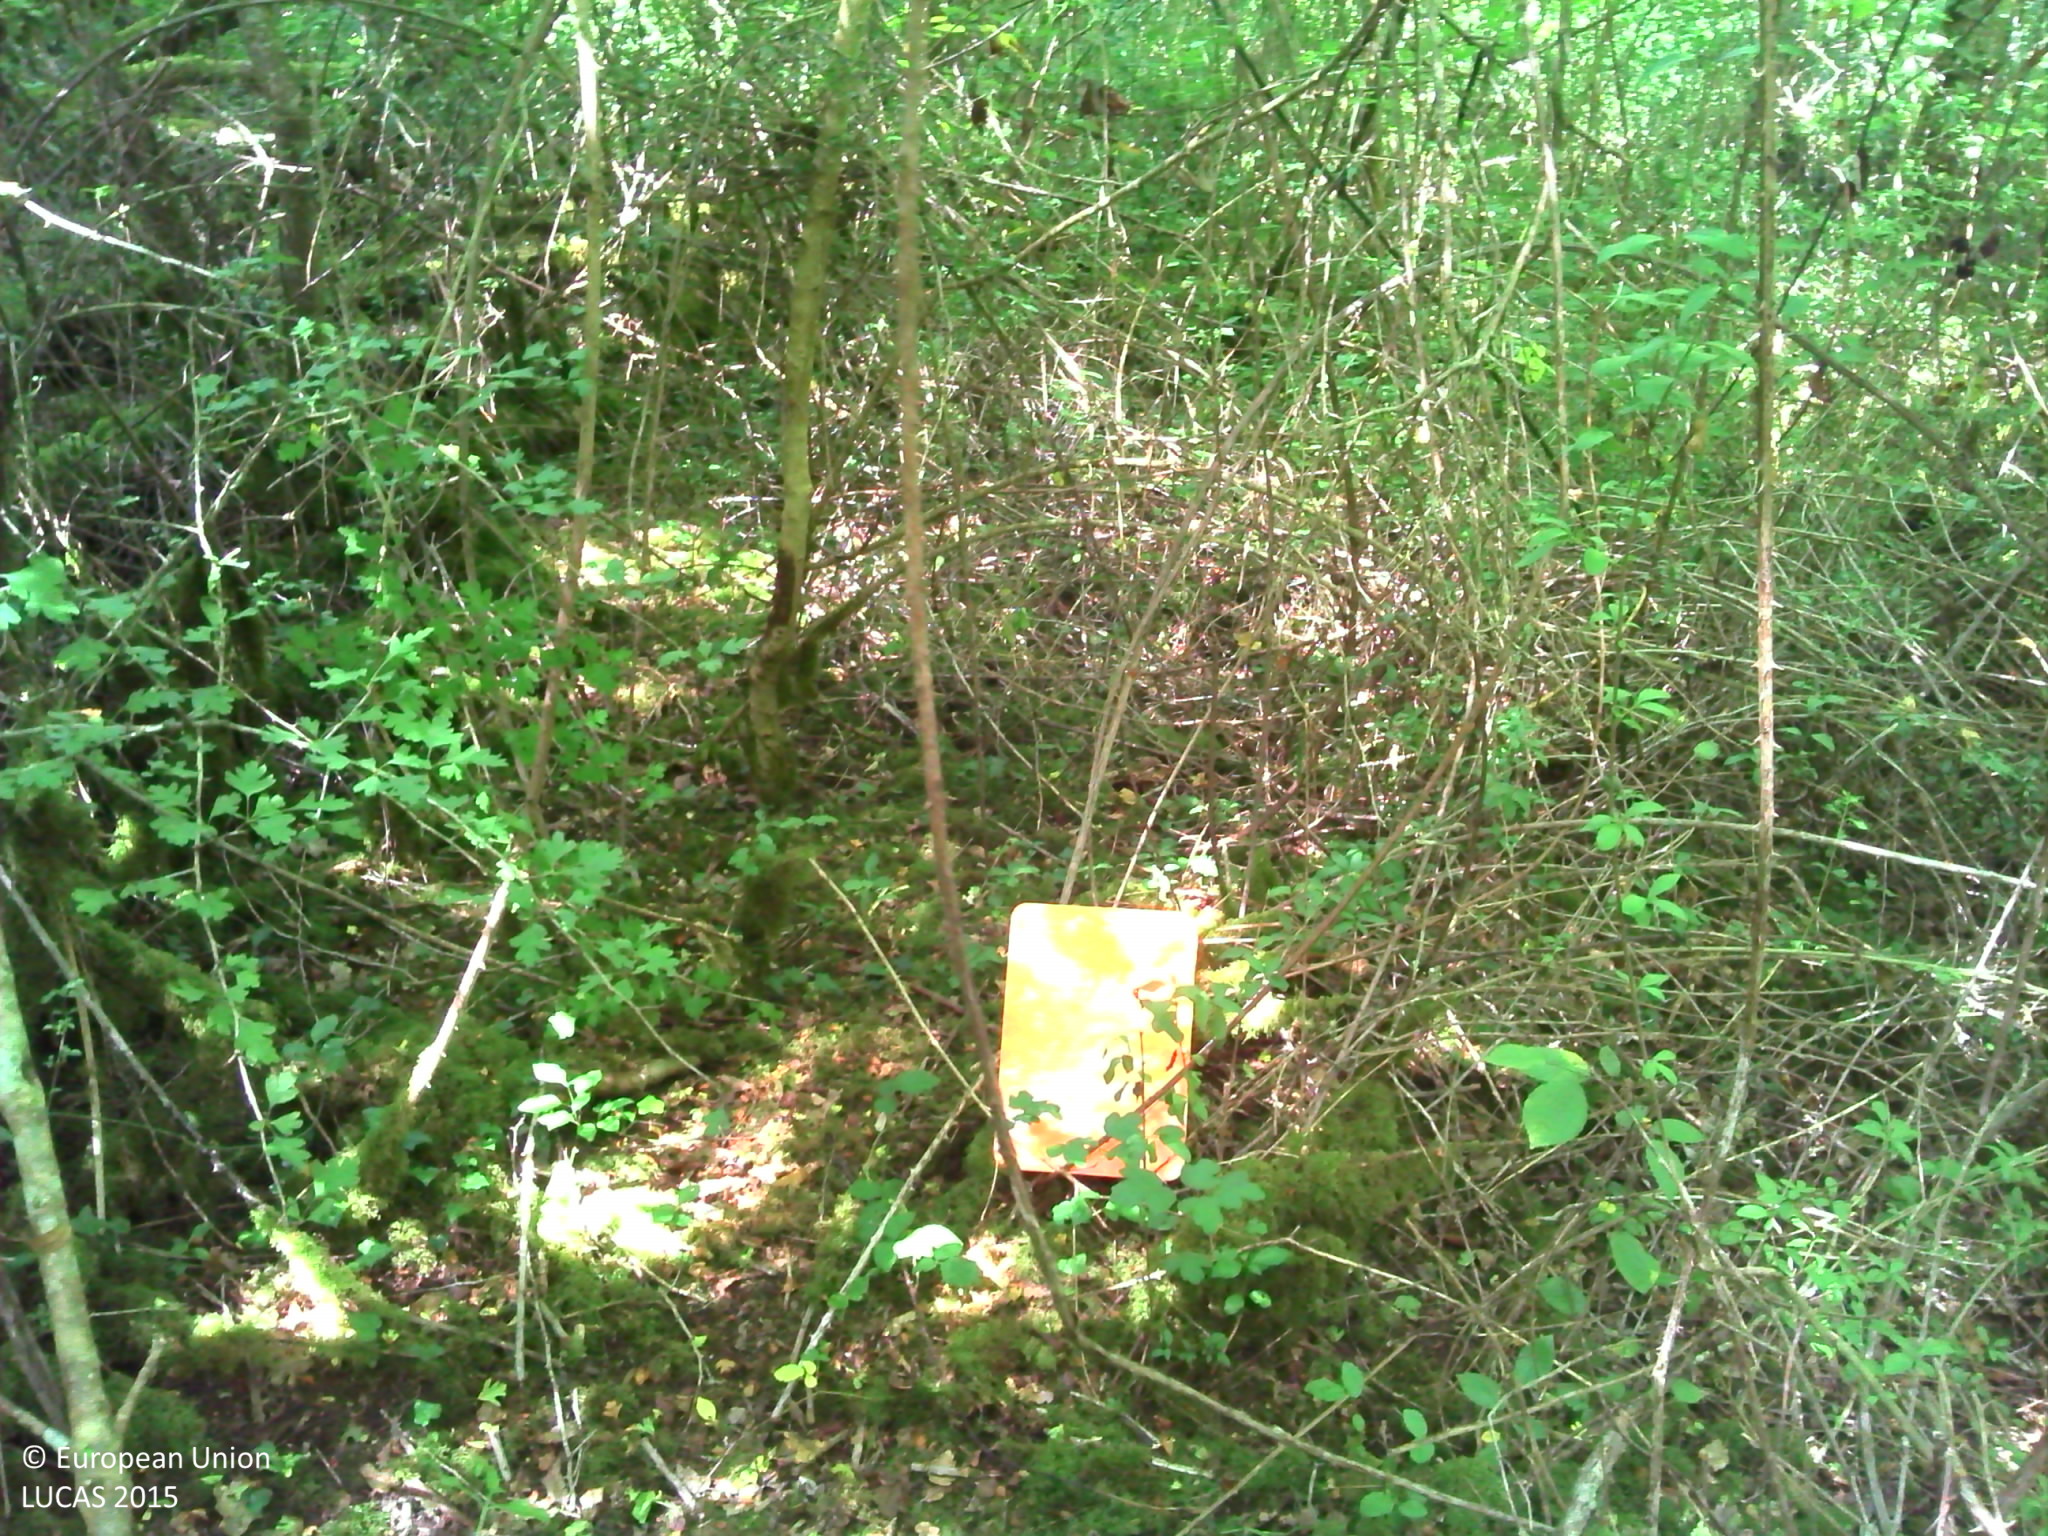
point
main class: Woodland
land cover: Broadleaved woodland
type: mesophytic deciduous forest
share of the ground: > 75 %
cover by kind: broadleaved forest trees 80 %, shrubs 15 %, herbaceous plants 5 %
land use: Forestry
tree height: > 5 m
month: June
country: FR
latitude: 45.7490
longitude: 0.3309
